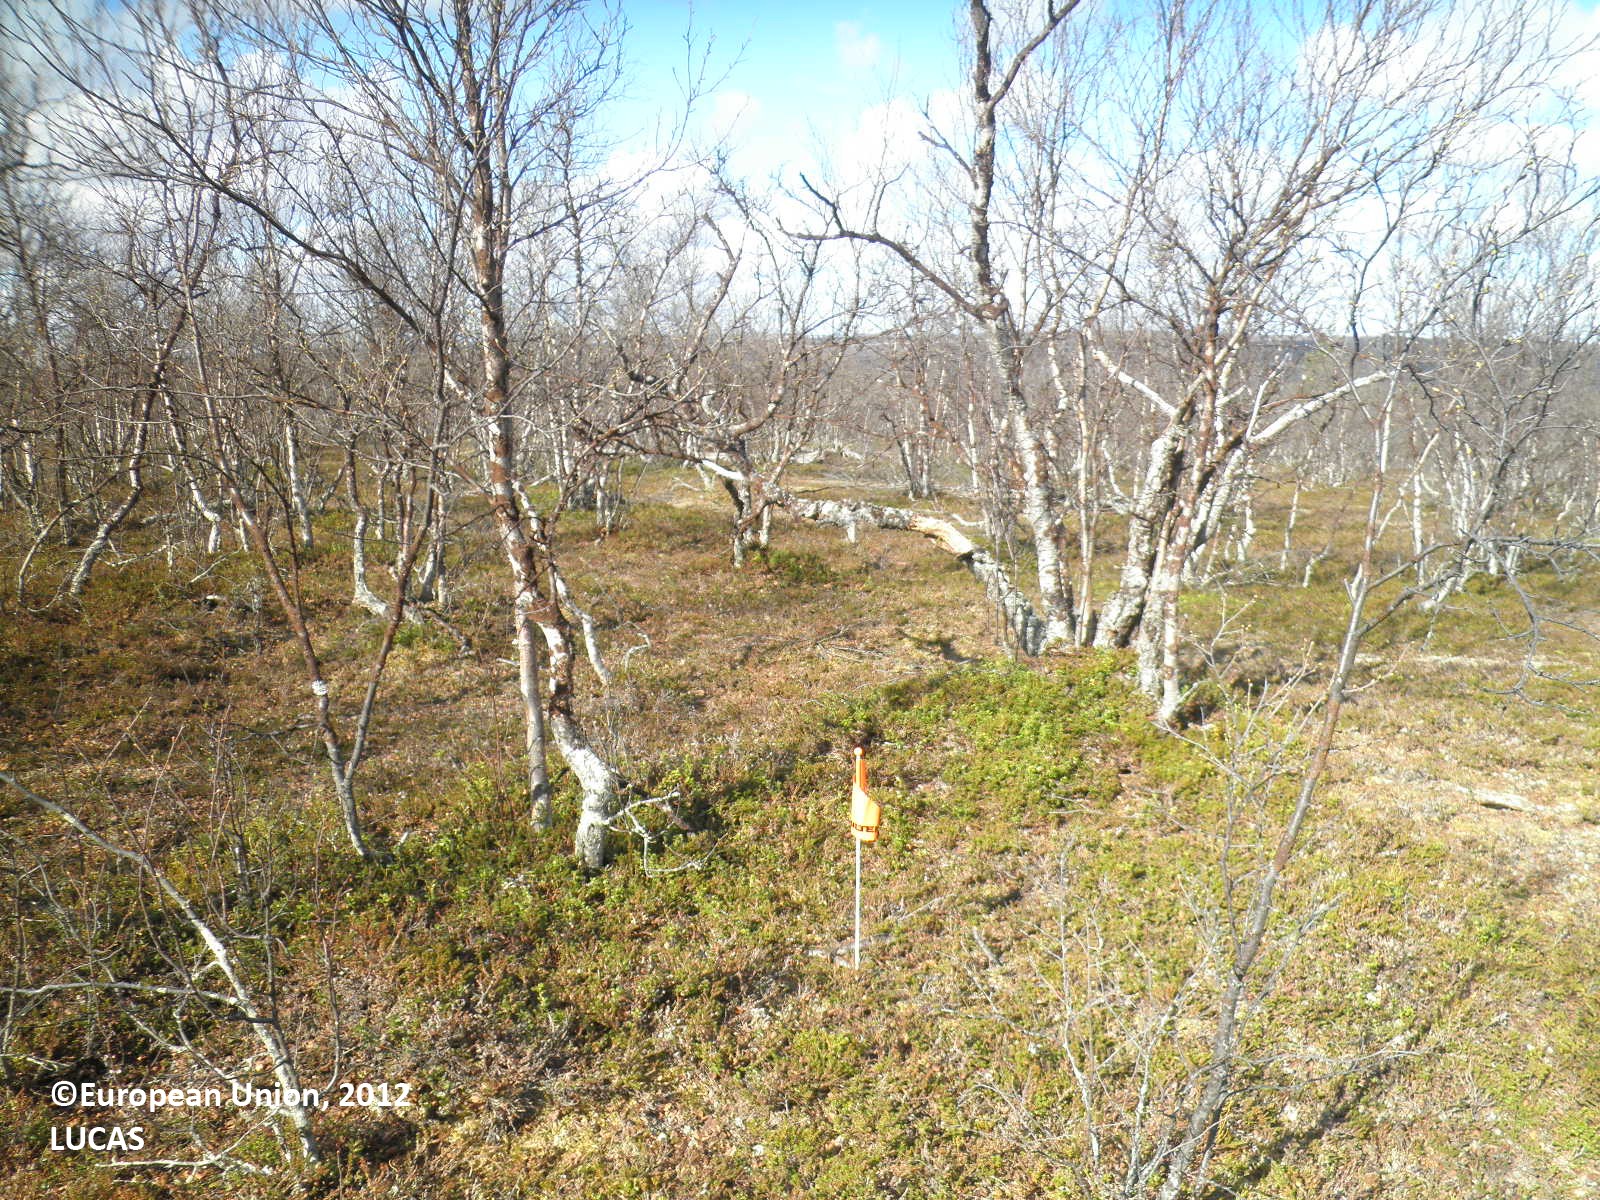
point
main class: Woodland
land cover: Broadleaved woodland
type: boreal forest
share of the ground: > 75 %
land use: Forestry
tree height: > 5 m
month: May
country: FI
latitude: 69.5095
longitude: 27.2295
